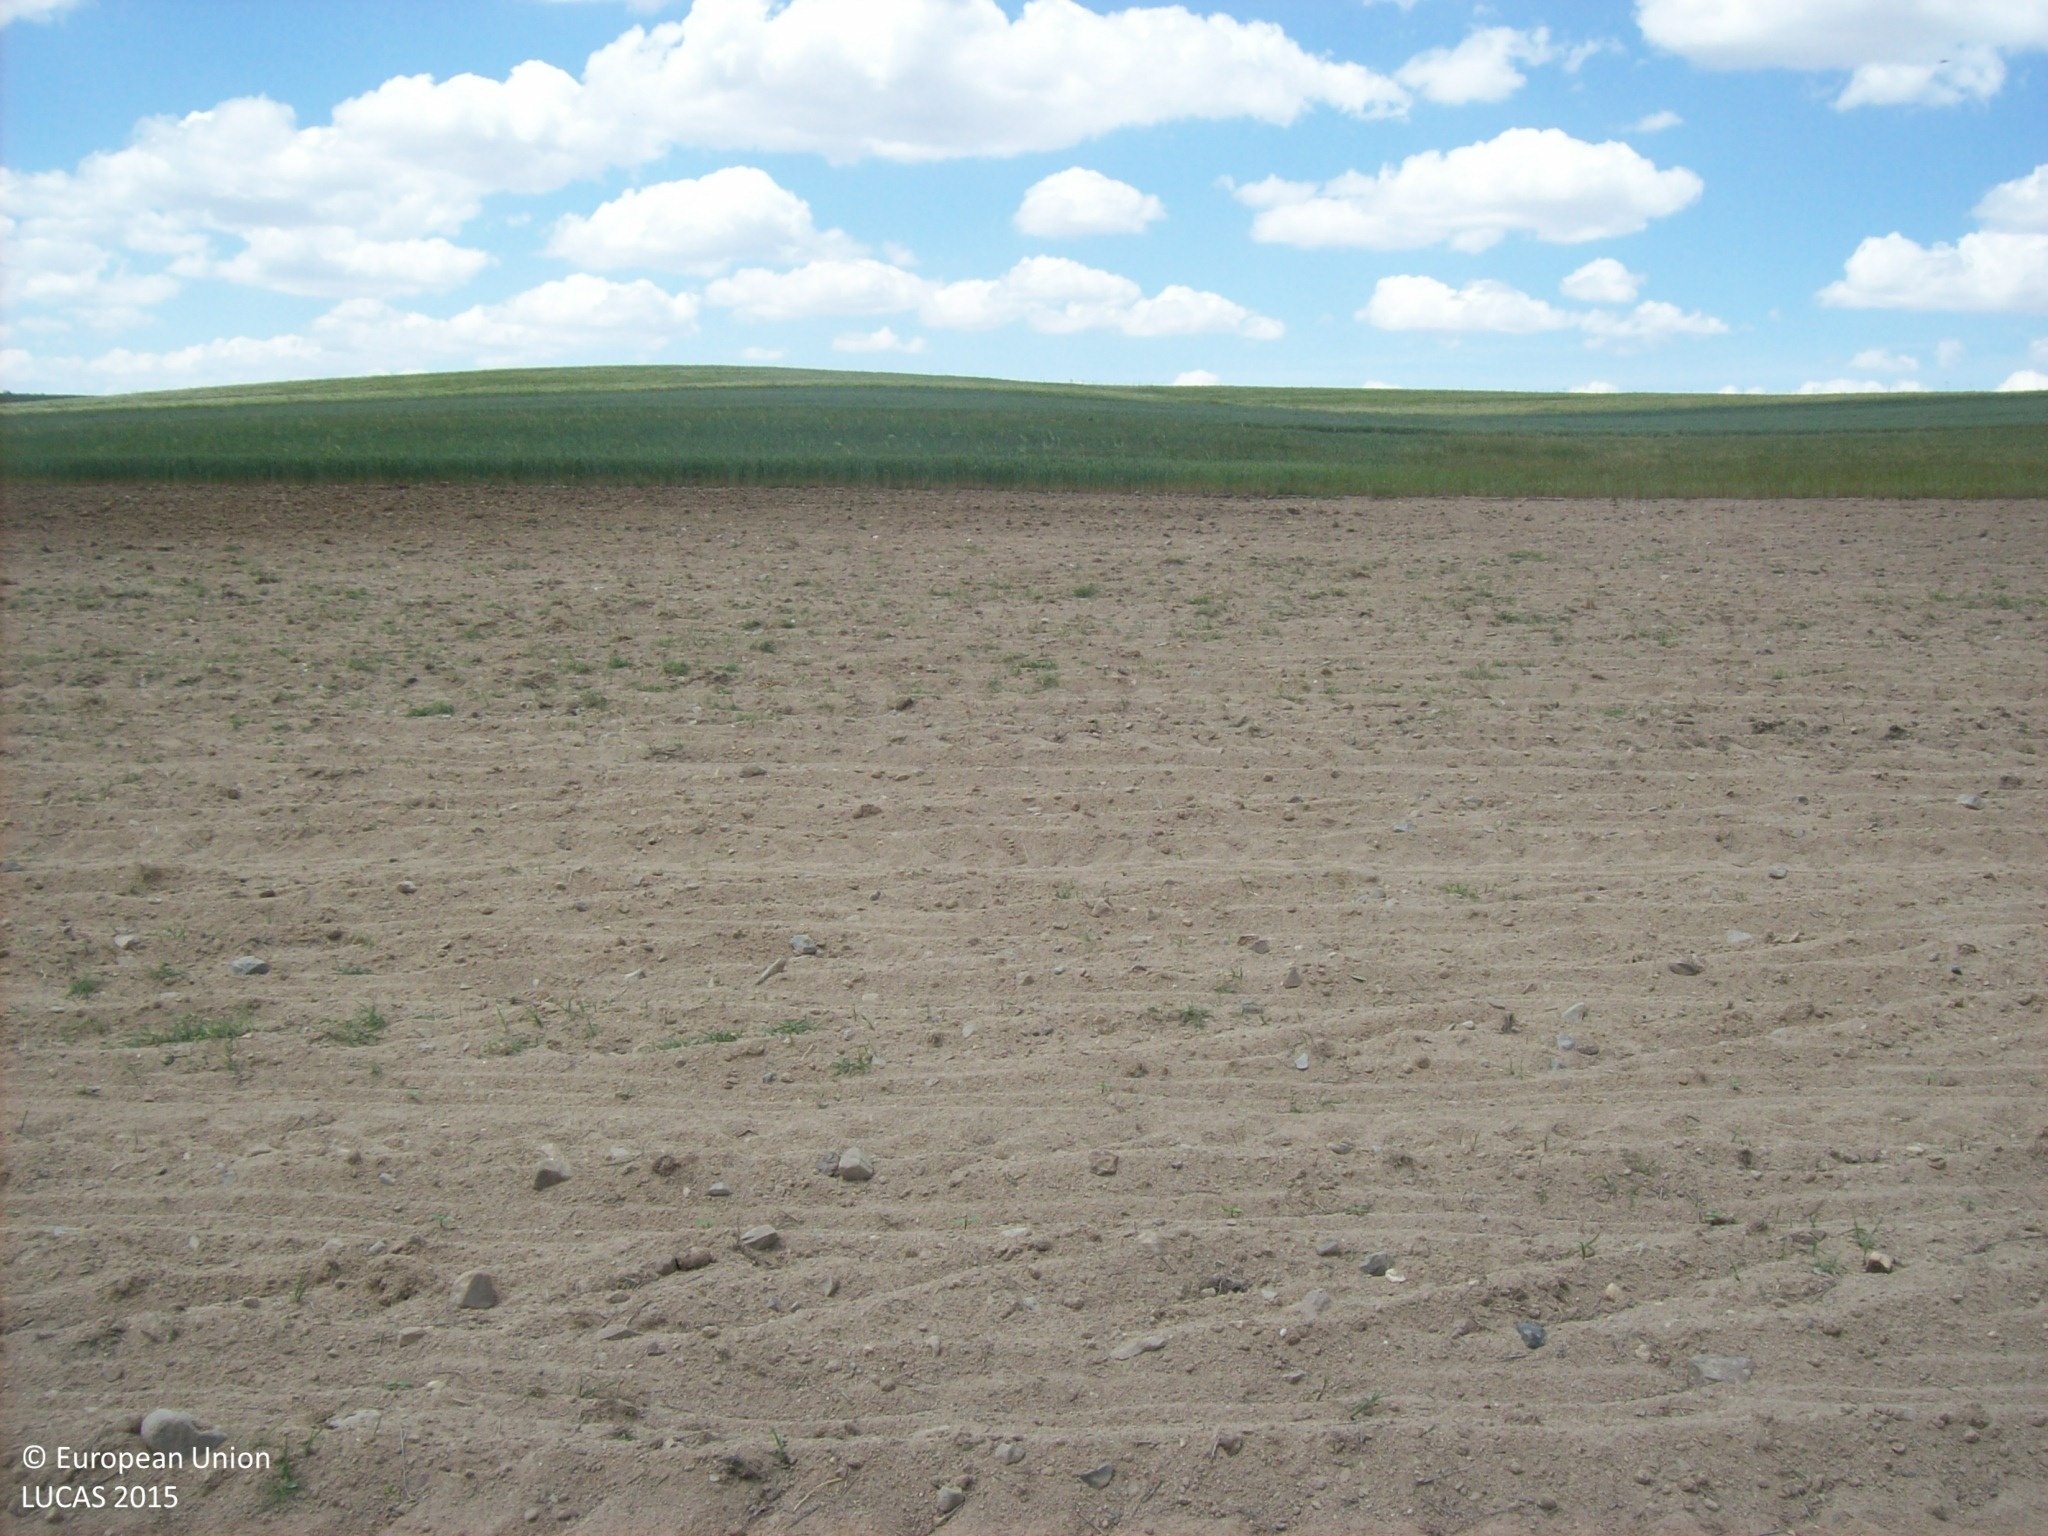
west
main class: Cropland
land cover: Sunflower
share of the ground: < 10 %
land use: Agriculture (excluding fallow land and kitchen gardens)
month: May
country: ES
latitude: 40.8753
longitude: -4.4722
